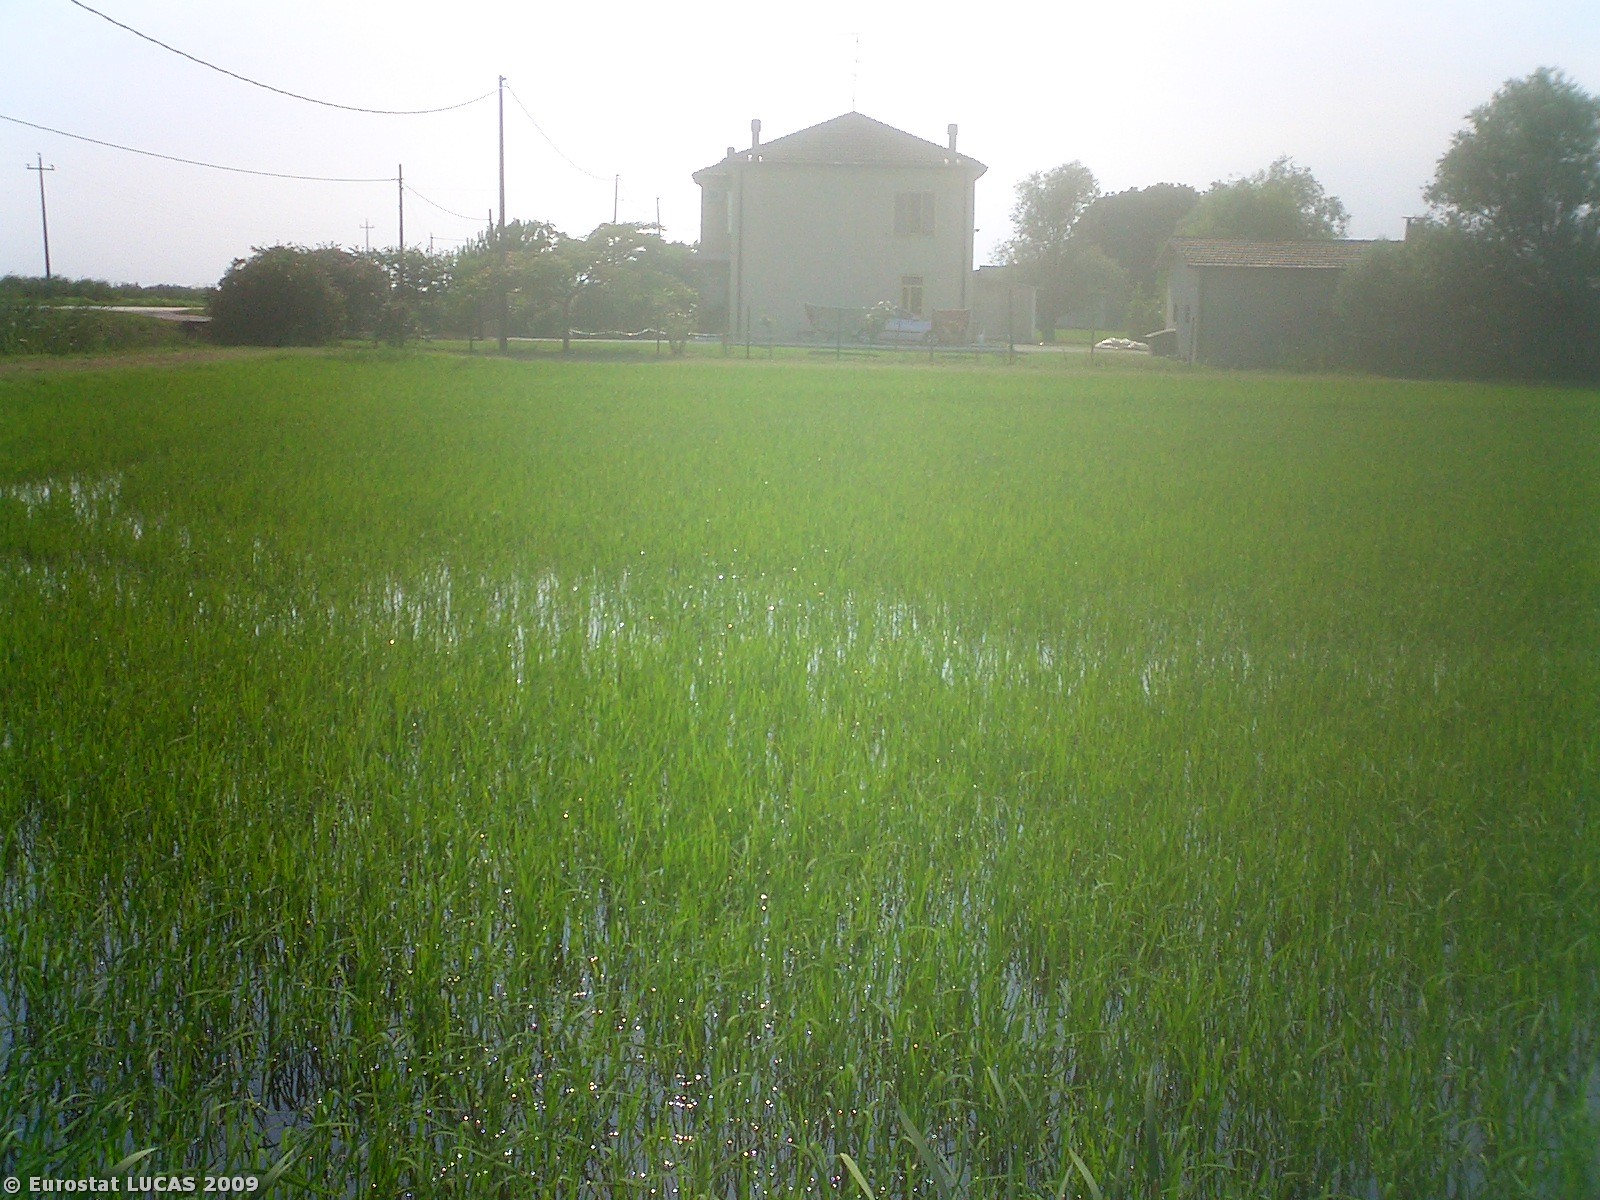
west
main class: Cropland
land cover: Rice
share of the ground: > 75 %
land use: Agriculture (excluding fallow land and kitchen gardens)
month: July
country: IT
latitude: 44.8888
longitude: 12.0852
